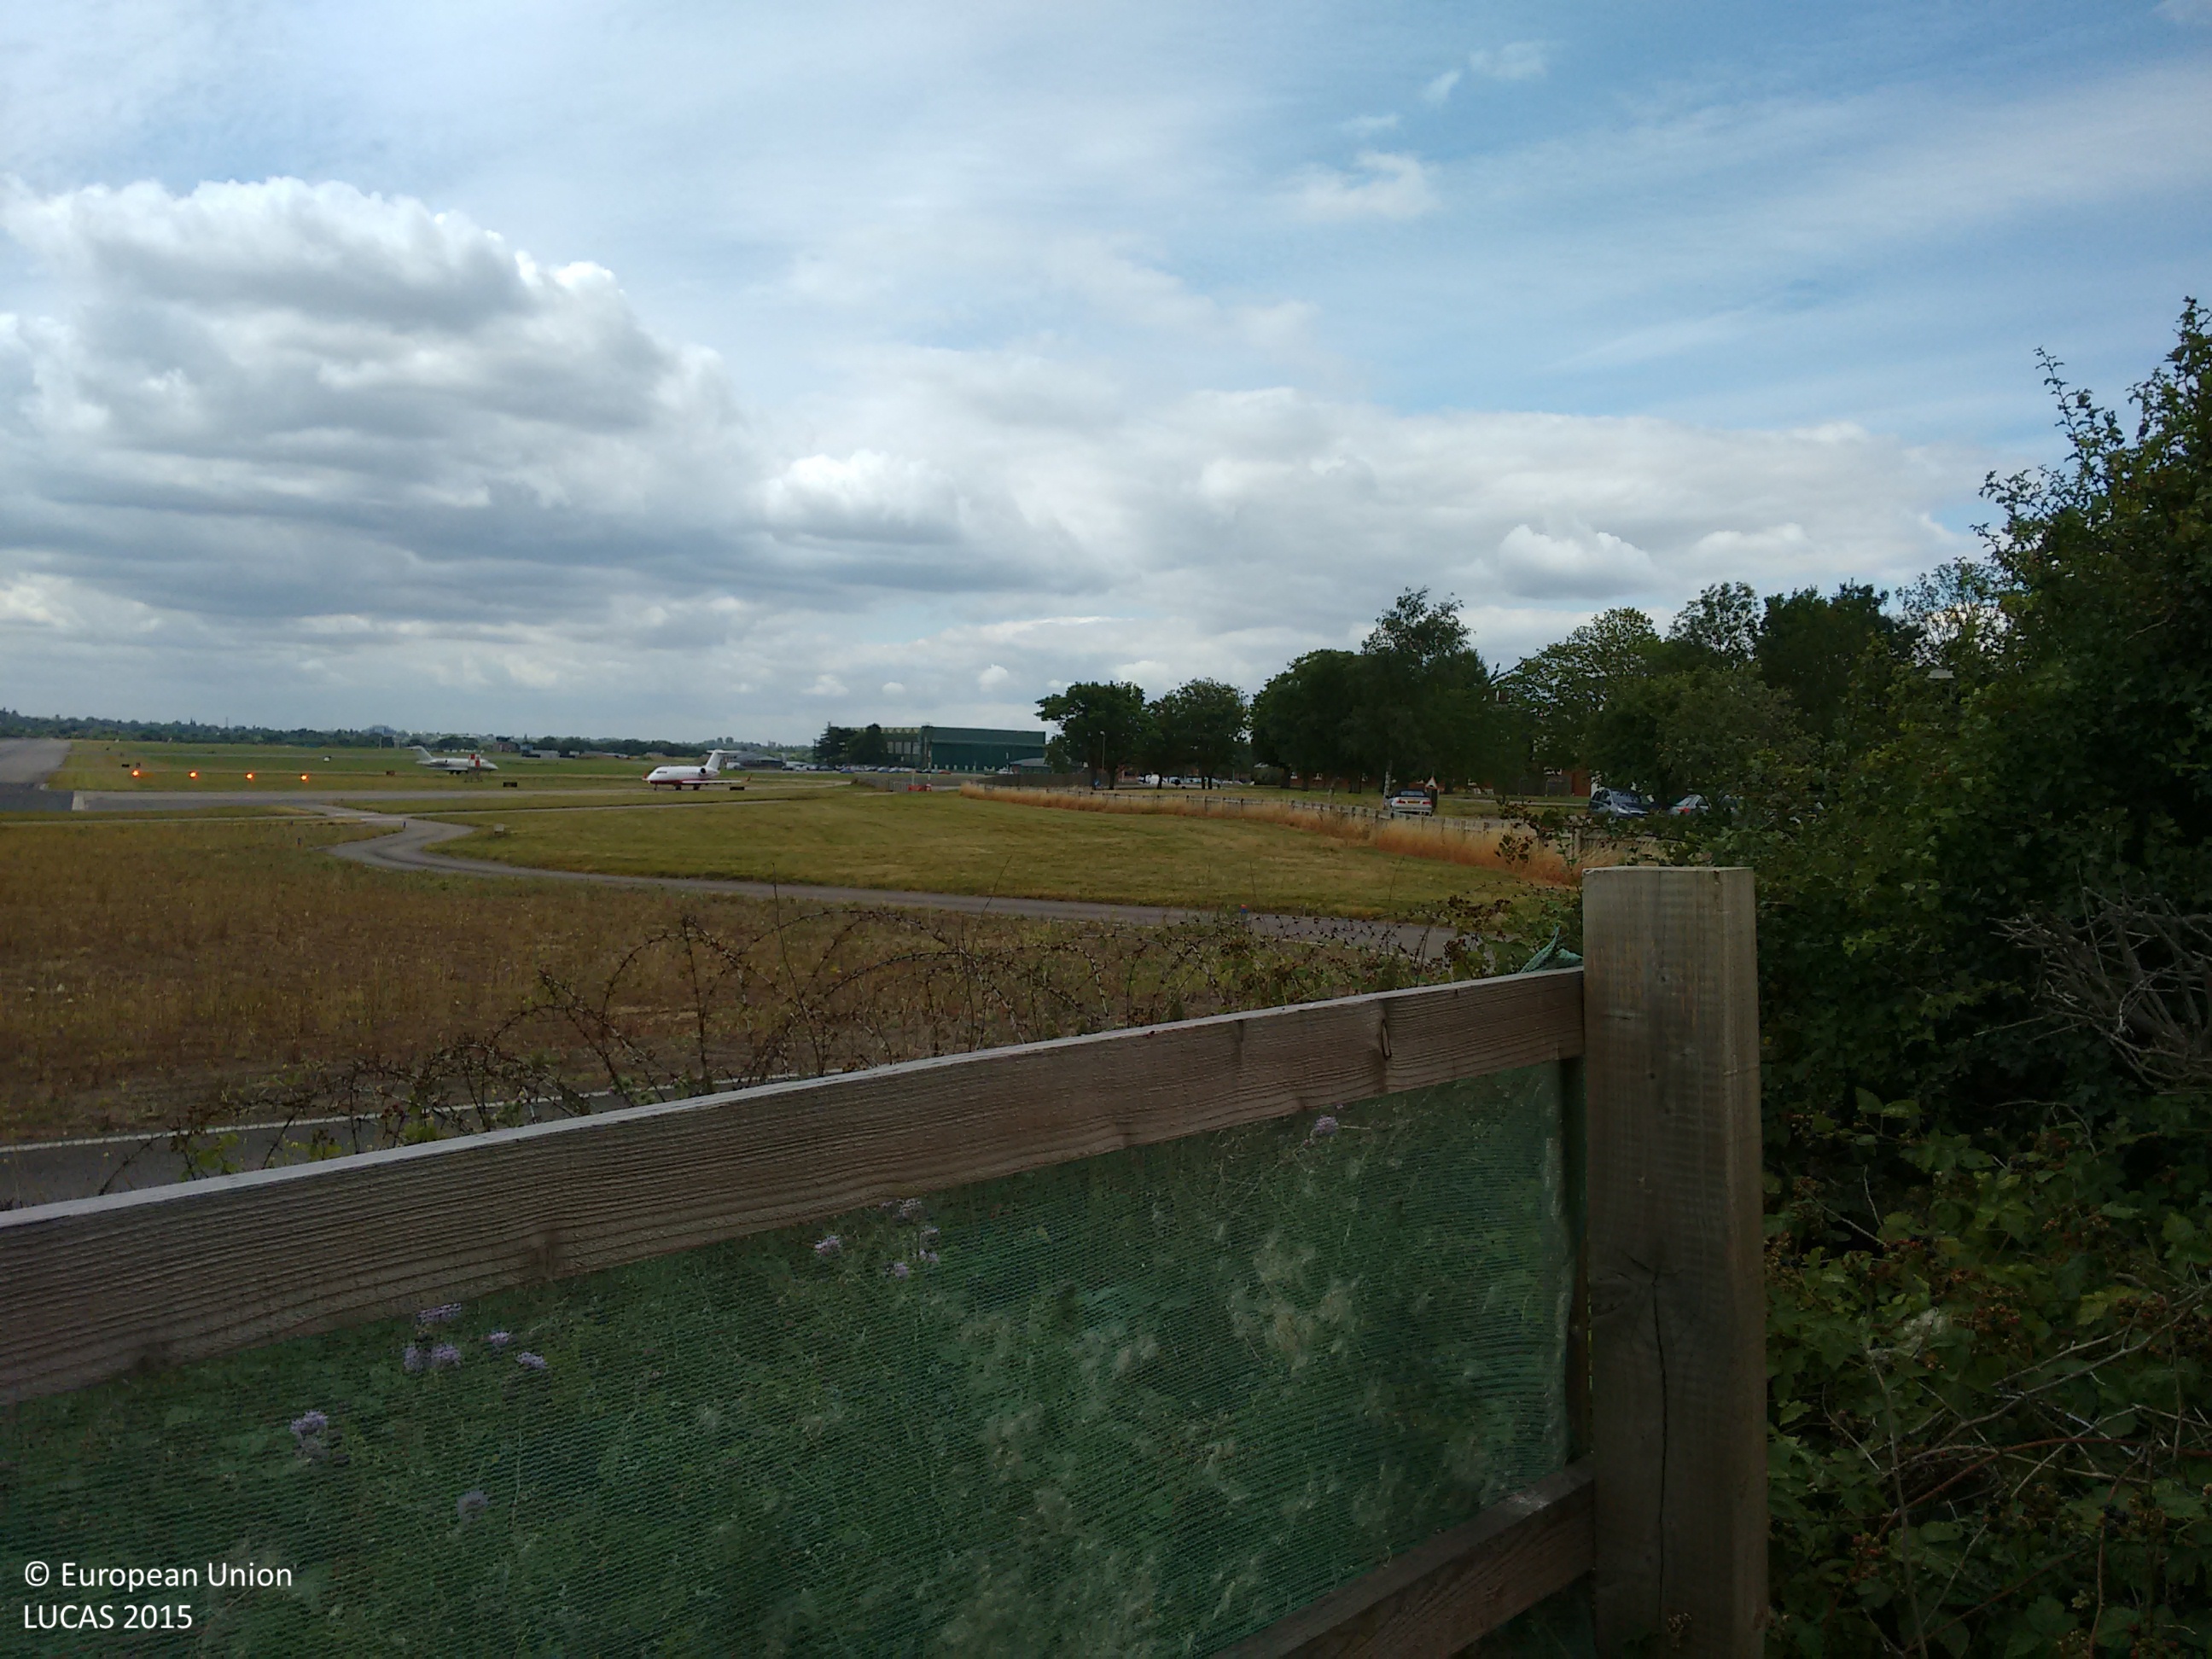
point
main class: Grassland
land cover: Grassland without tree/shrub cover
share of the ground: > 75 %
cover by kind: herbaceous plants 100 %
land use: Air transport
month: July
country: GB
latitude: 51.5561
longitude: -0.4076
